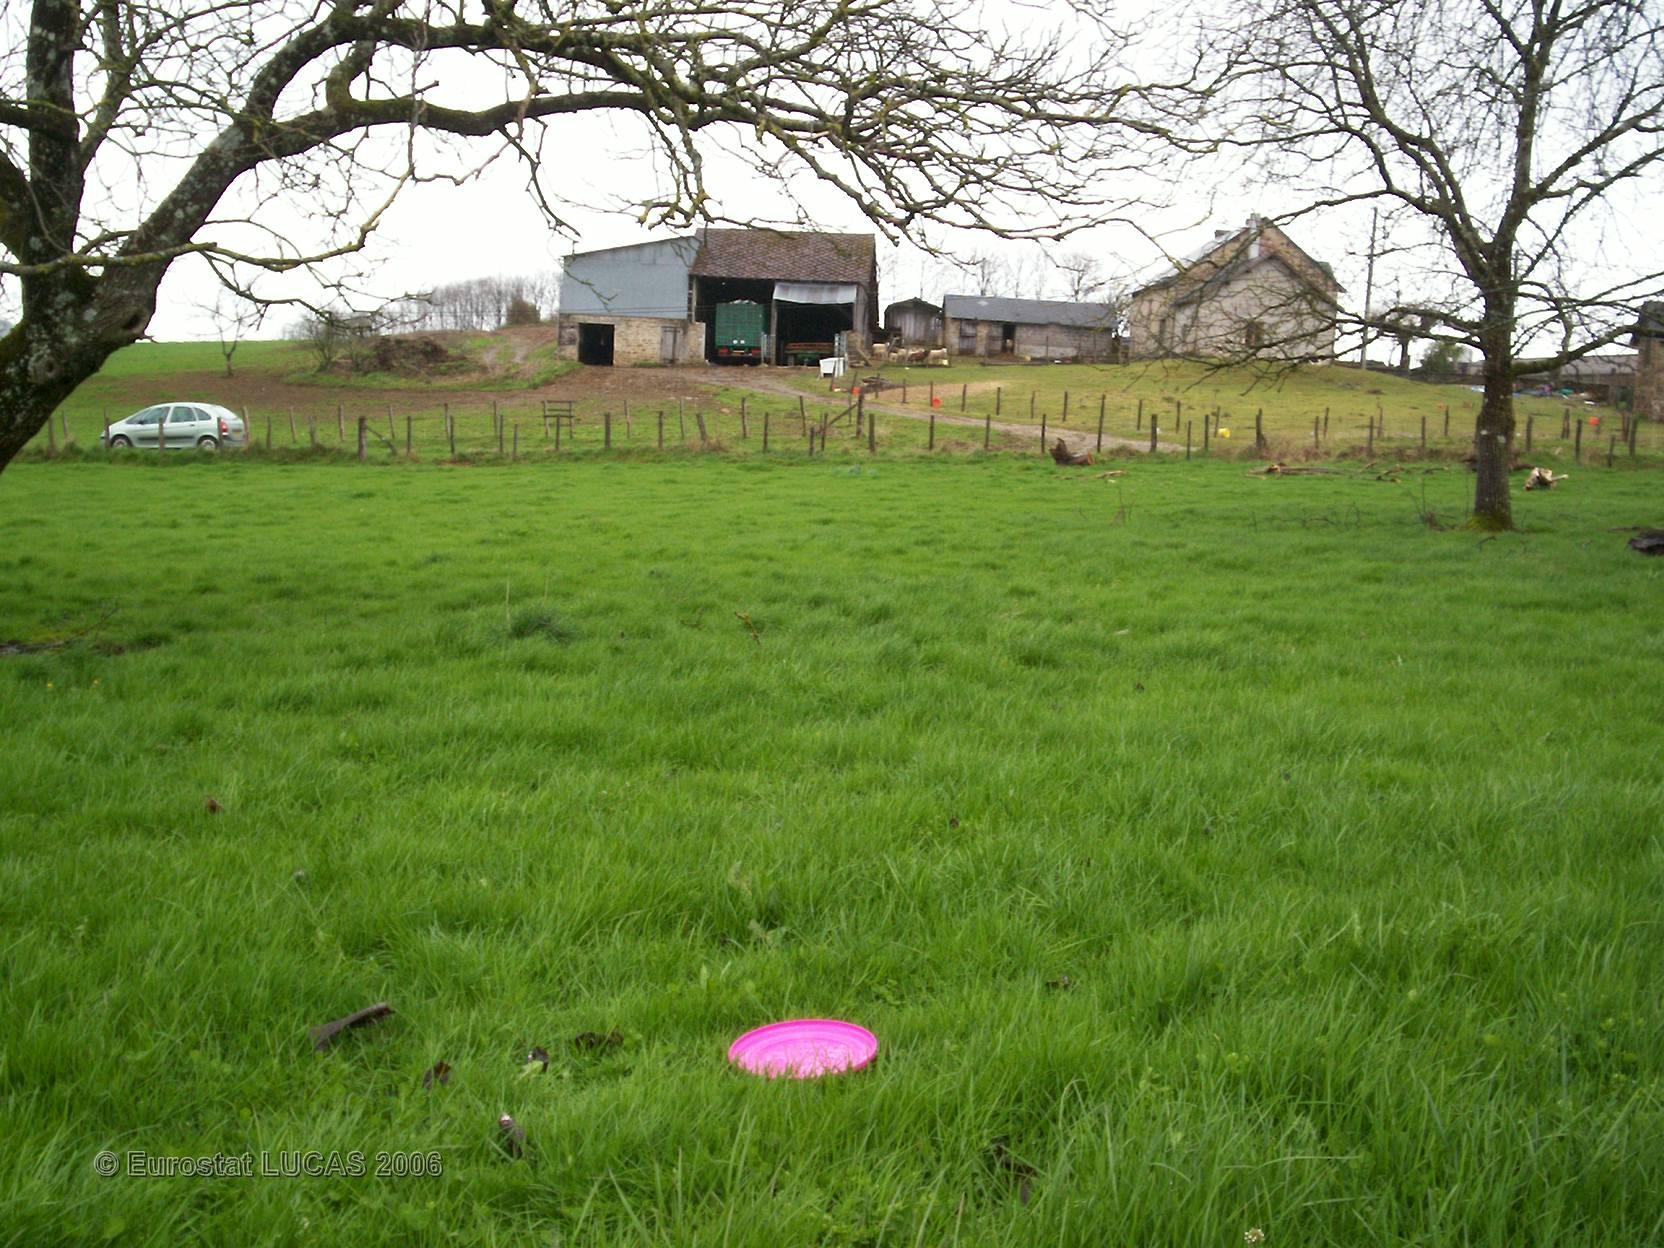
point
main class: Grassland
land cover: Grassland with sparse tree/shrub cover
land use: Agriculture (excluding fallow land and kitchen gardens)
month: April
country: FR
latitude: 45.5678
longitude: 1.6014
